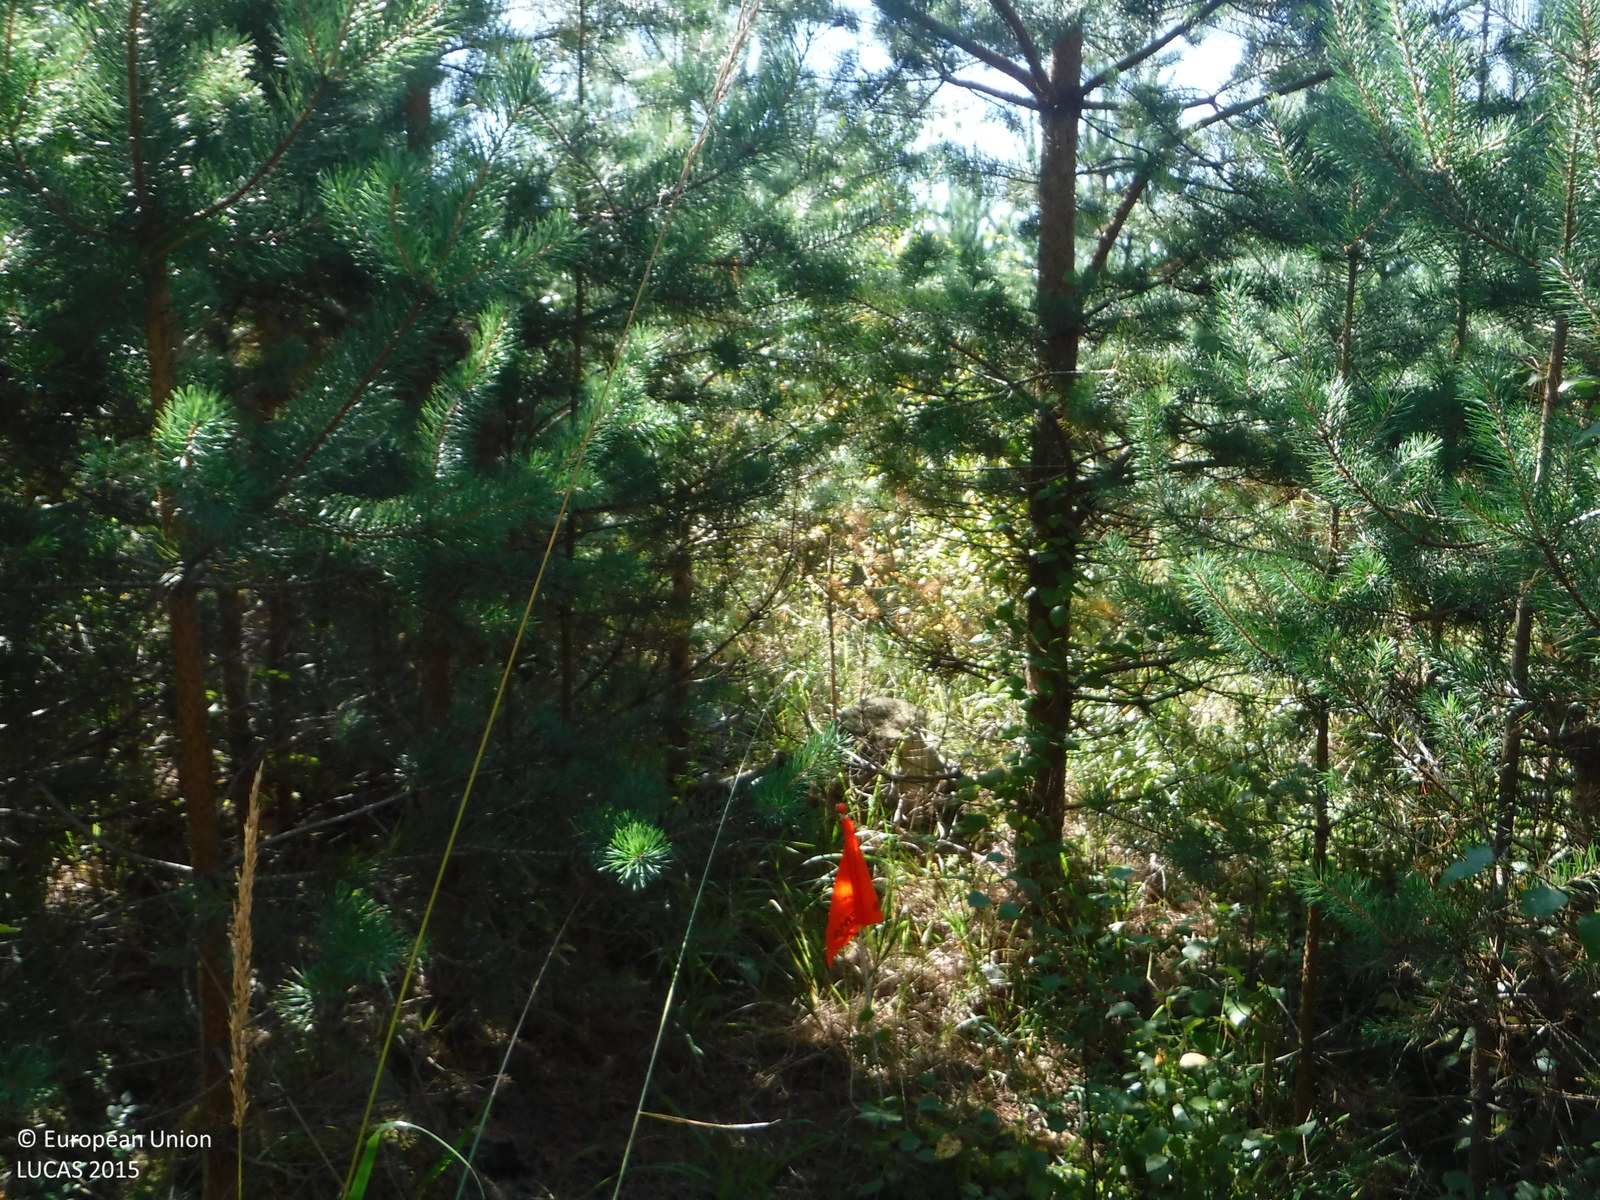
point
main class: Woodland
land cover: Pine dominated mixed woodland
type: boreal forest
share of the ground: 50 - 75 %
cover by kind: coniferous forest trees 45 %, broadleaved forest trees 25 %, shrubs 10 %, herbaceous plants 10 %, lichens and mosses 10 %
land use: Forestry
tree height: < 5 m
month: August
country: FI
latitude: 61.1775
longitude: 22.8832
